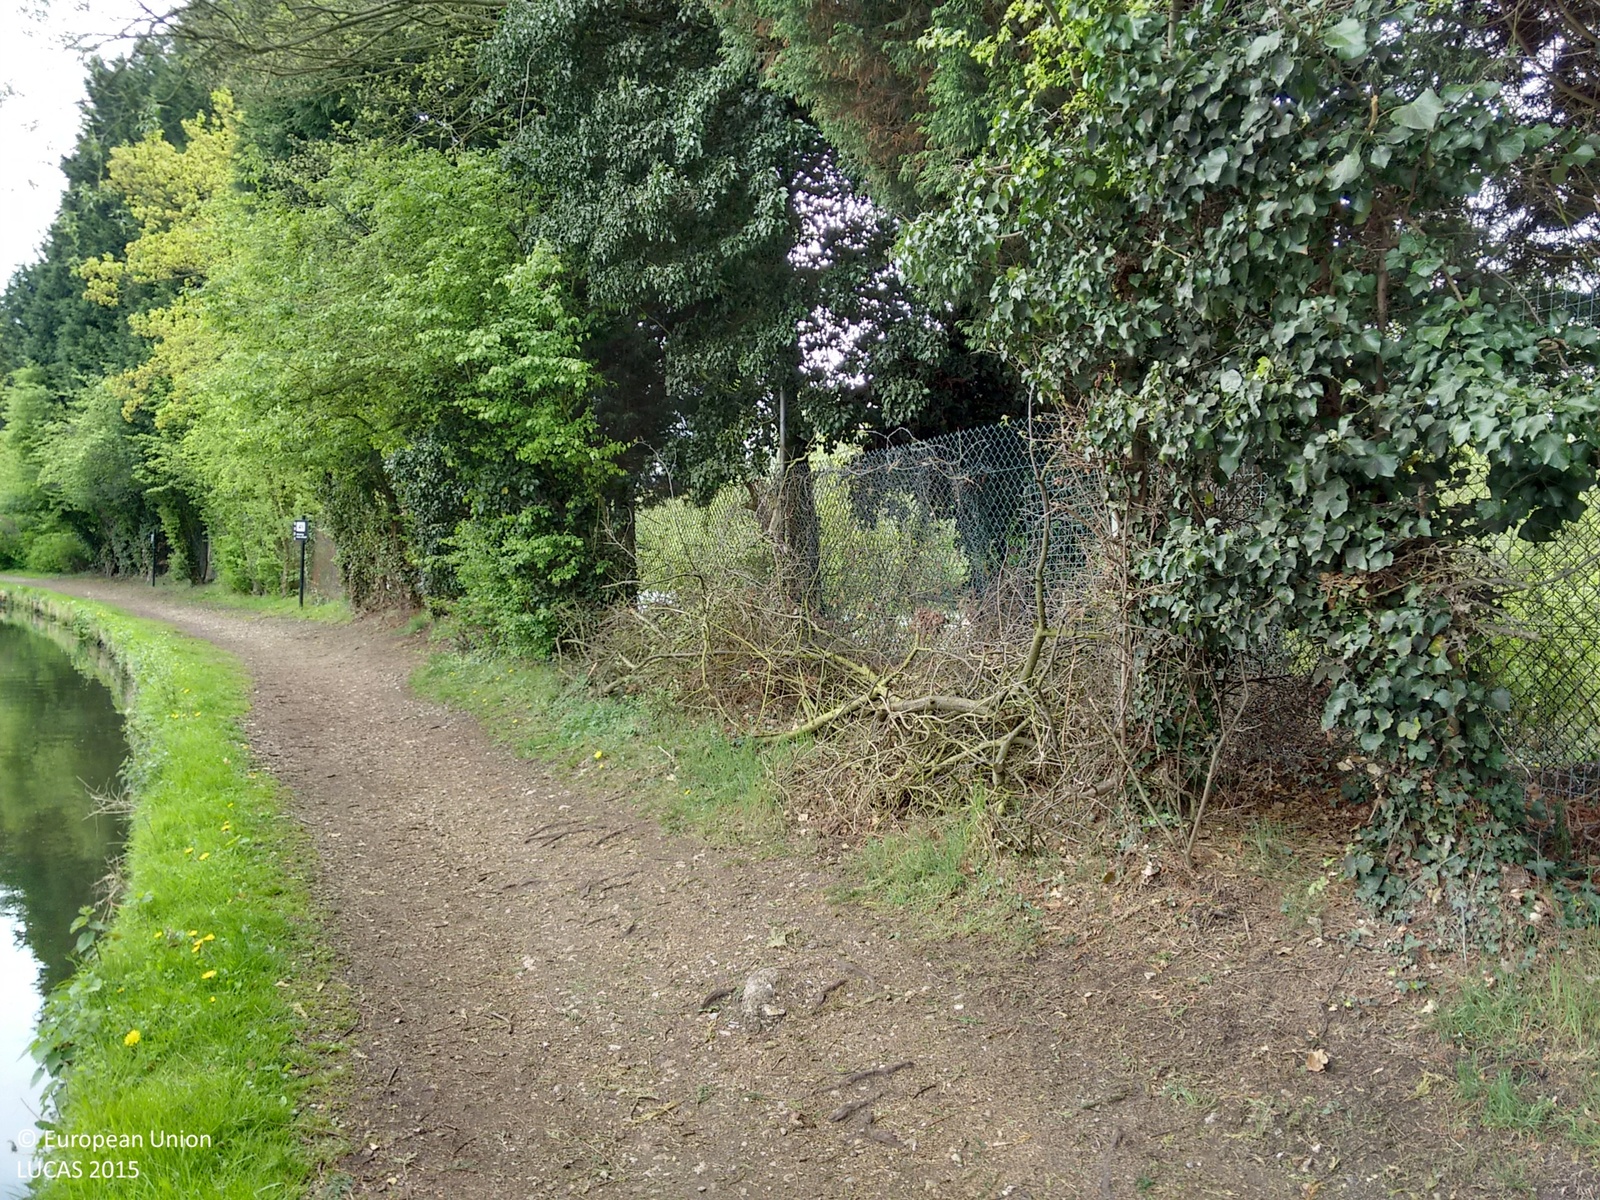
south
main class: Grassland
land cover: Grassland without tree/shrub cover
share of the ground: > 75 %
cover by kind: herbaceous plants 100 %
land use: Amenities, museums, leisure
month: May
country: GB
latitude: 51.7463
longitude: -0.5103
